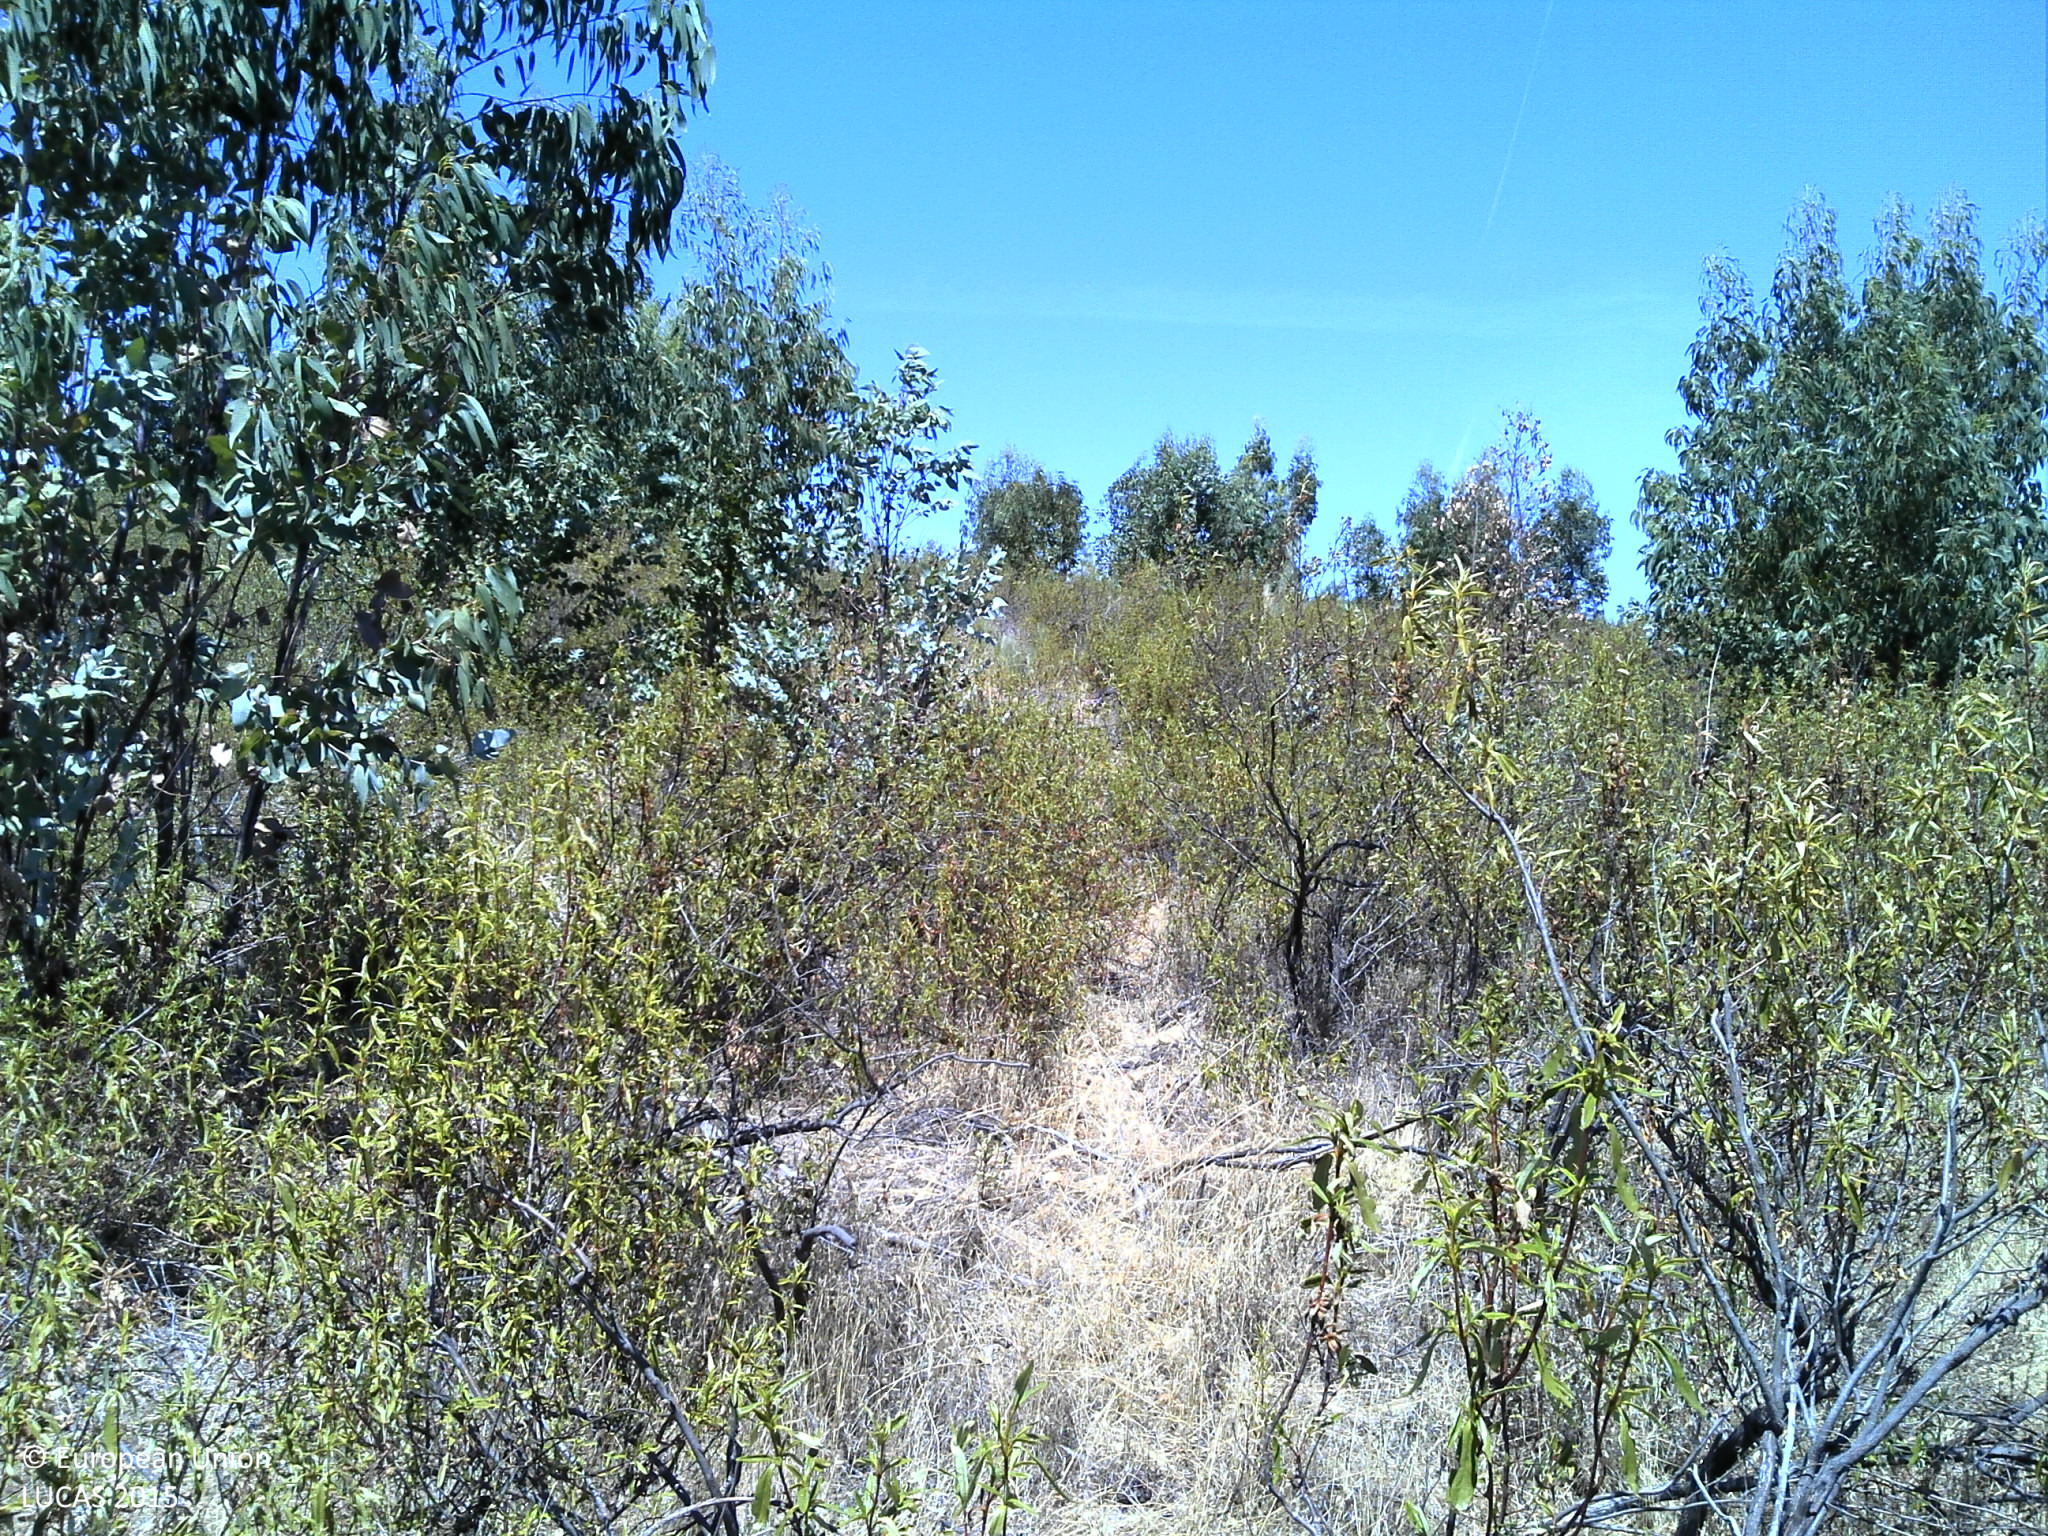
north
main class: Woodland
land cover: Broadleaved woodland
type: exotic forest
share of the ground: 10 - 25 %
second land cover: Shrubland without tree cover
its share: > 75 %
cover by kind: shrubs 90 %, broadleaved forest trees 10 %
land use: Forestry
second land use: Agriculture (excluding fallow land and kitchen gardens)
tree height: > 5 m
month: August
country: PT
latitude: 39.5364
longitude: -7.4642
